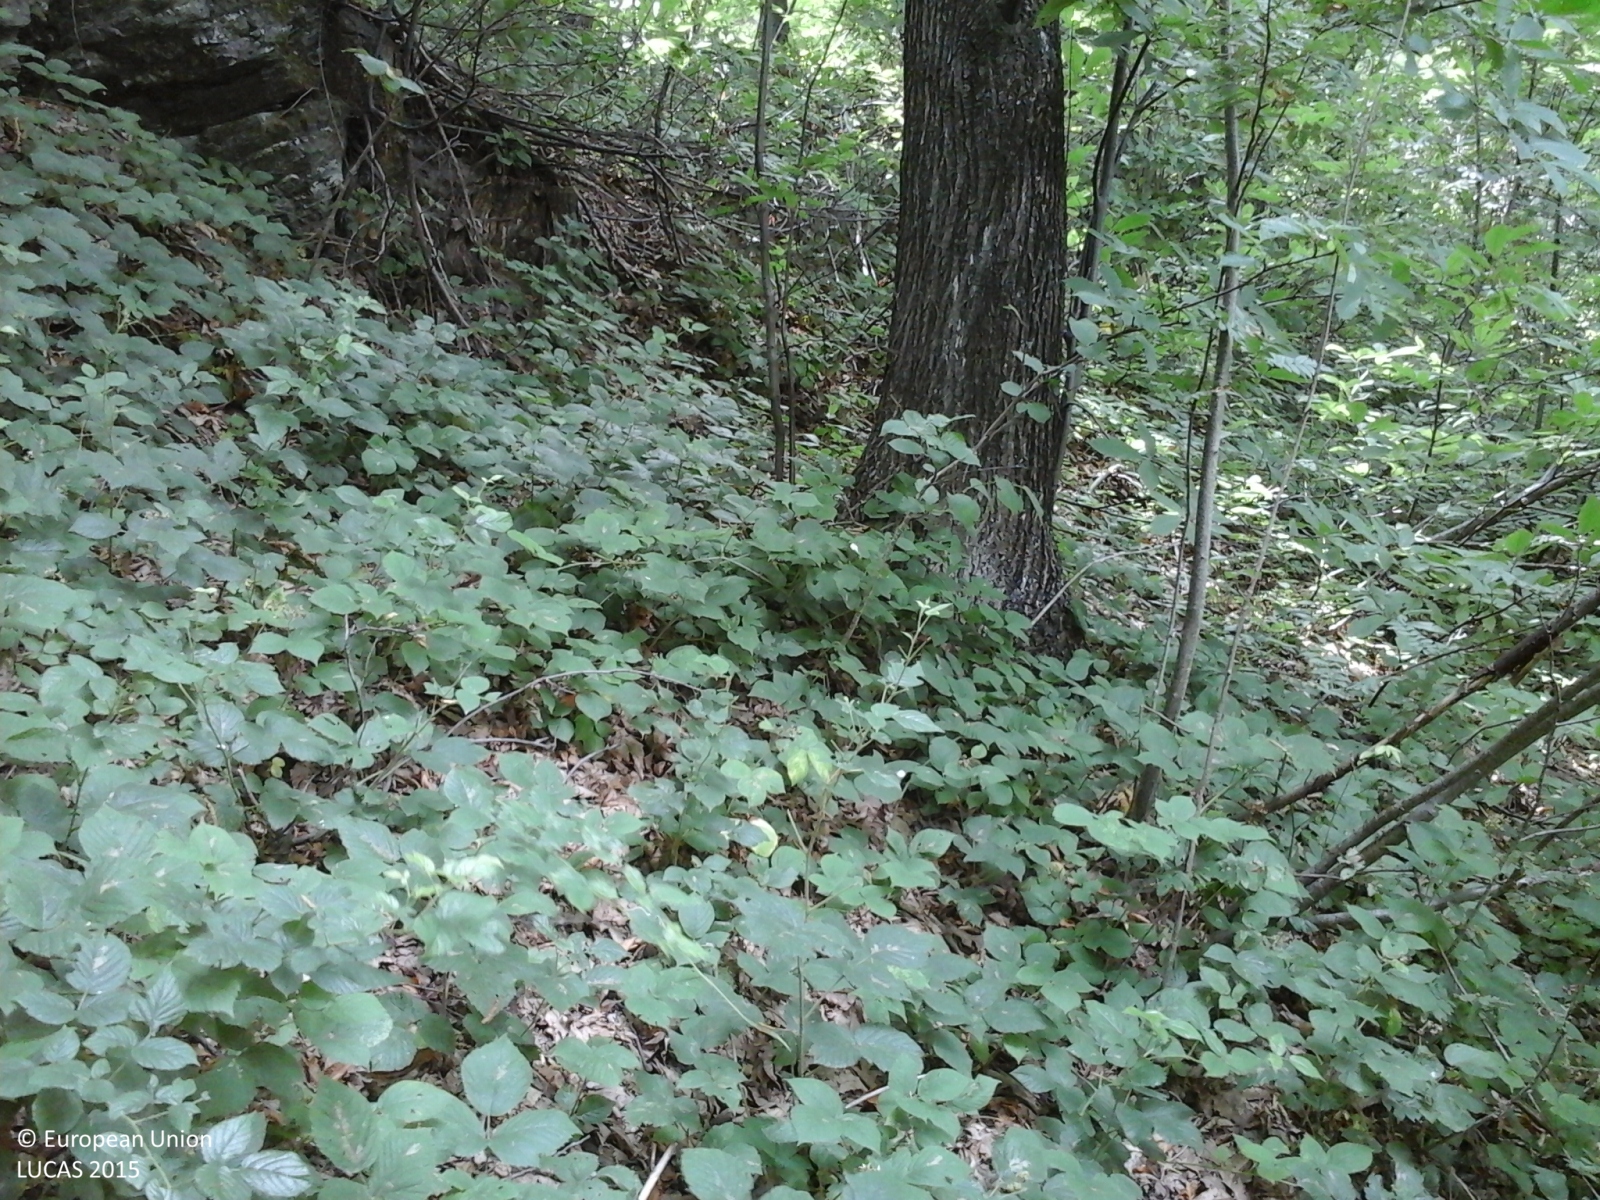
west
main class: Woodland
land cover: Broadleaved woodland
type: mesophytic deciduous forest
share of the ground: > 75 %
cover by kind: broadleaved forest trees 95 %, shrubs 5 %
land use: Forestry
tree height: > 5 m
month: July
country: IT
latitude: 44.3033
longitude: 7.5359
